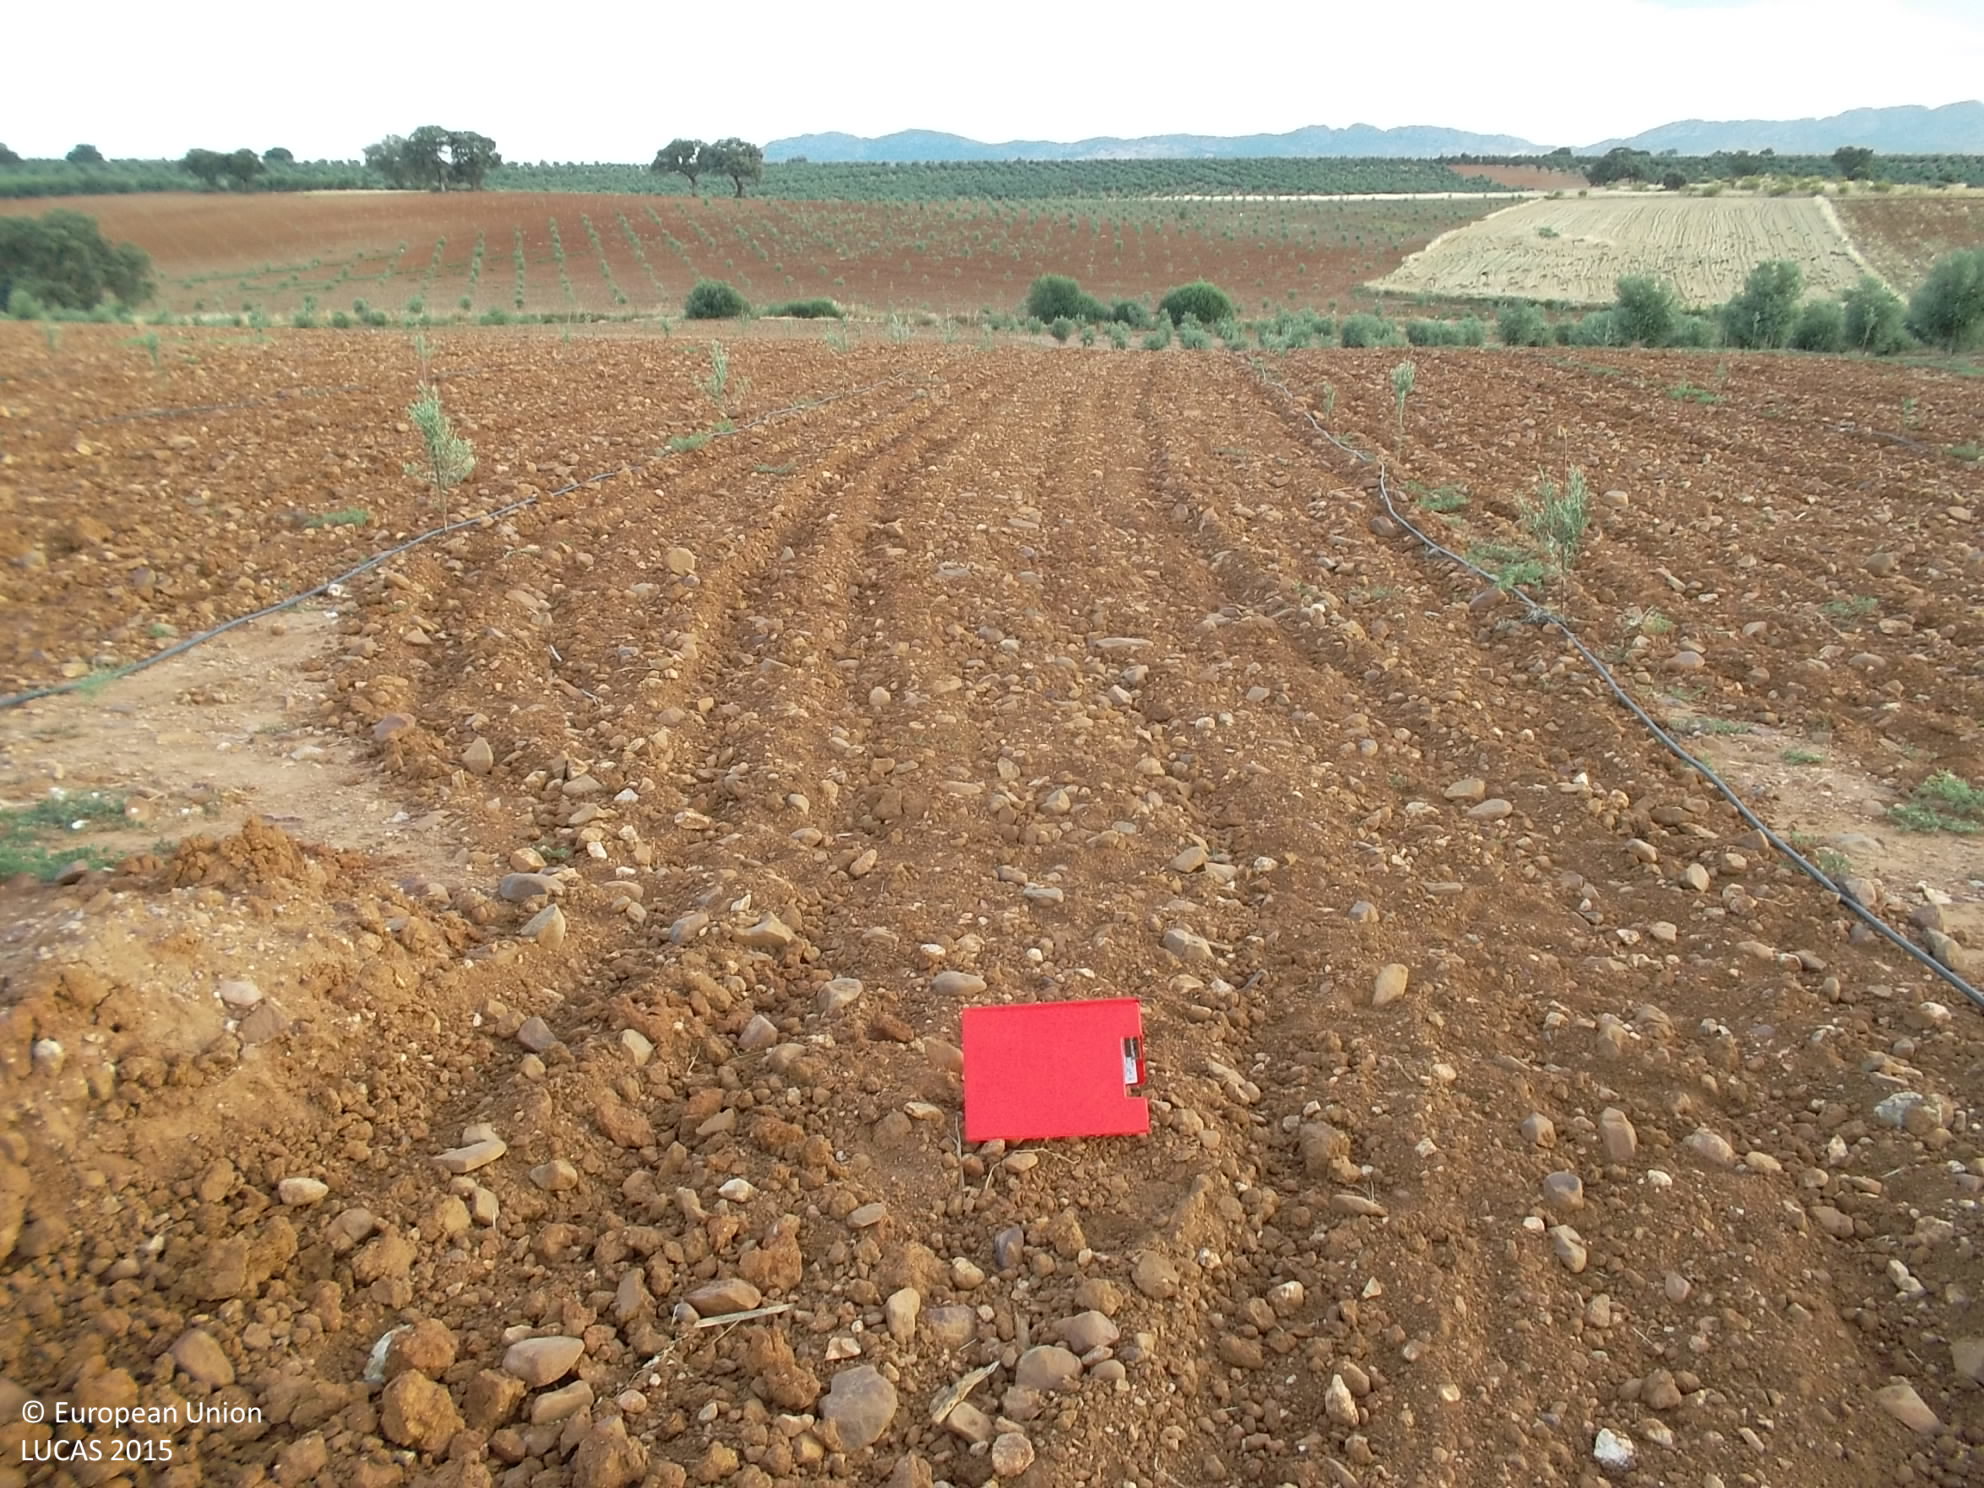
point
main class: Cropland
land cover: Olive groves
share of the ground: 10 - 25 %
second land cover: Other bare soil
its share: > 75 %
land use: Agriculture (excluding fallow land and kitchen gardens)
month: July
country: ES
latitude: 38.6002
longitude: -5.4105
